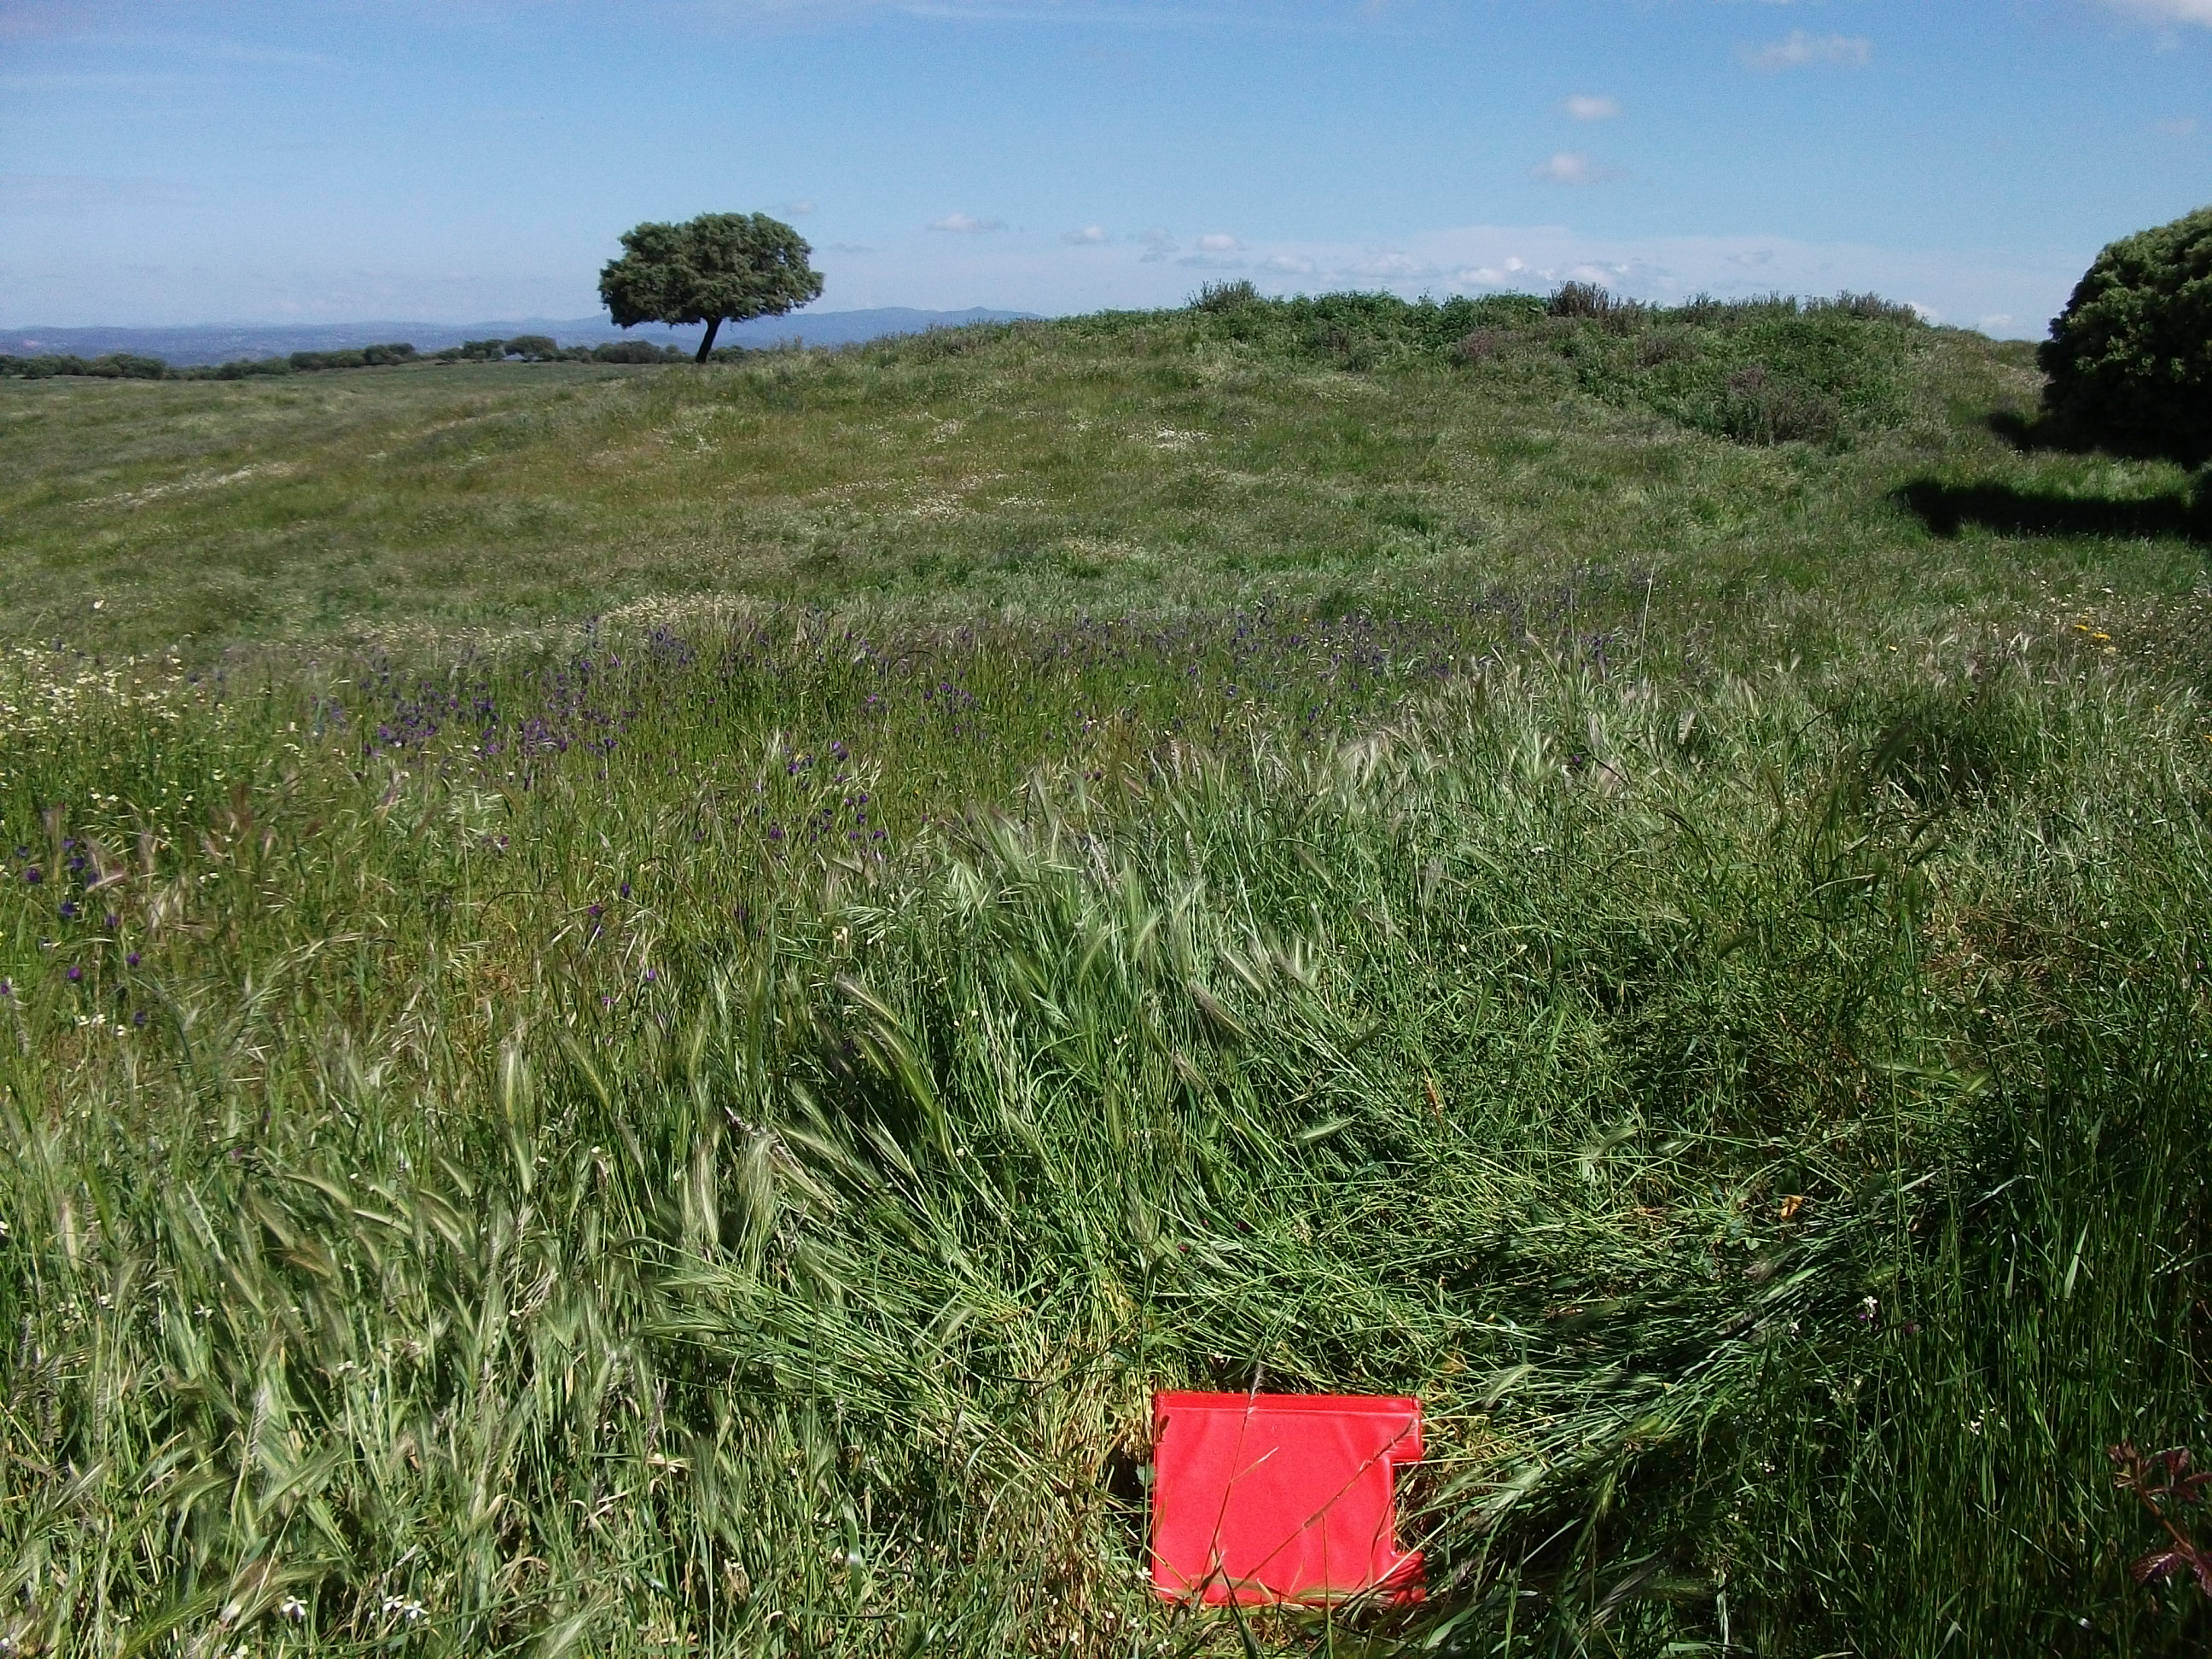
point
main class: Grassland
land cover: Grassland without tree/shrub cover
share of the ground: > 75 %
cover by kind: herbaceous plants 100 %
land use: Agriculture (excluding fallow land and kitchen gardens)
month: April
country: ES
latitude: 38.1661
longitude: -6.7738
